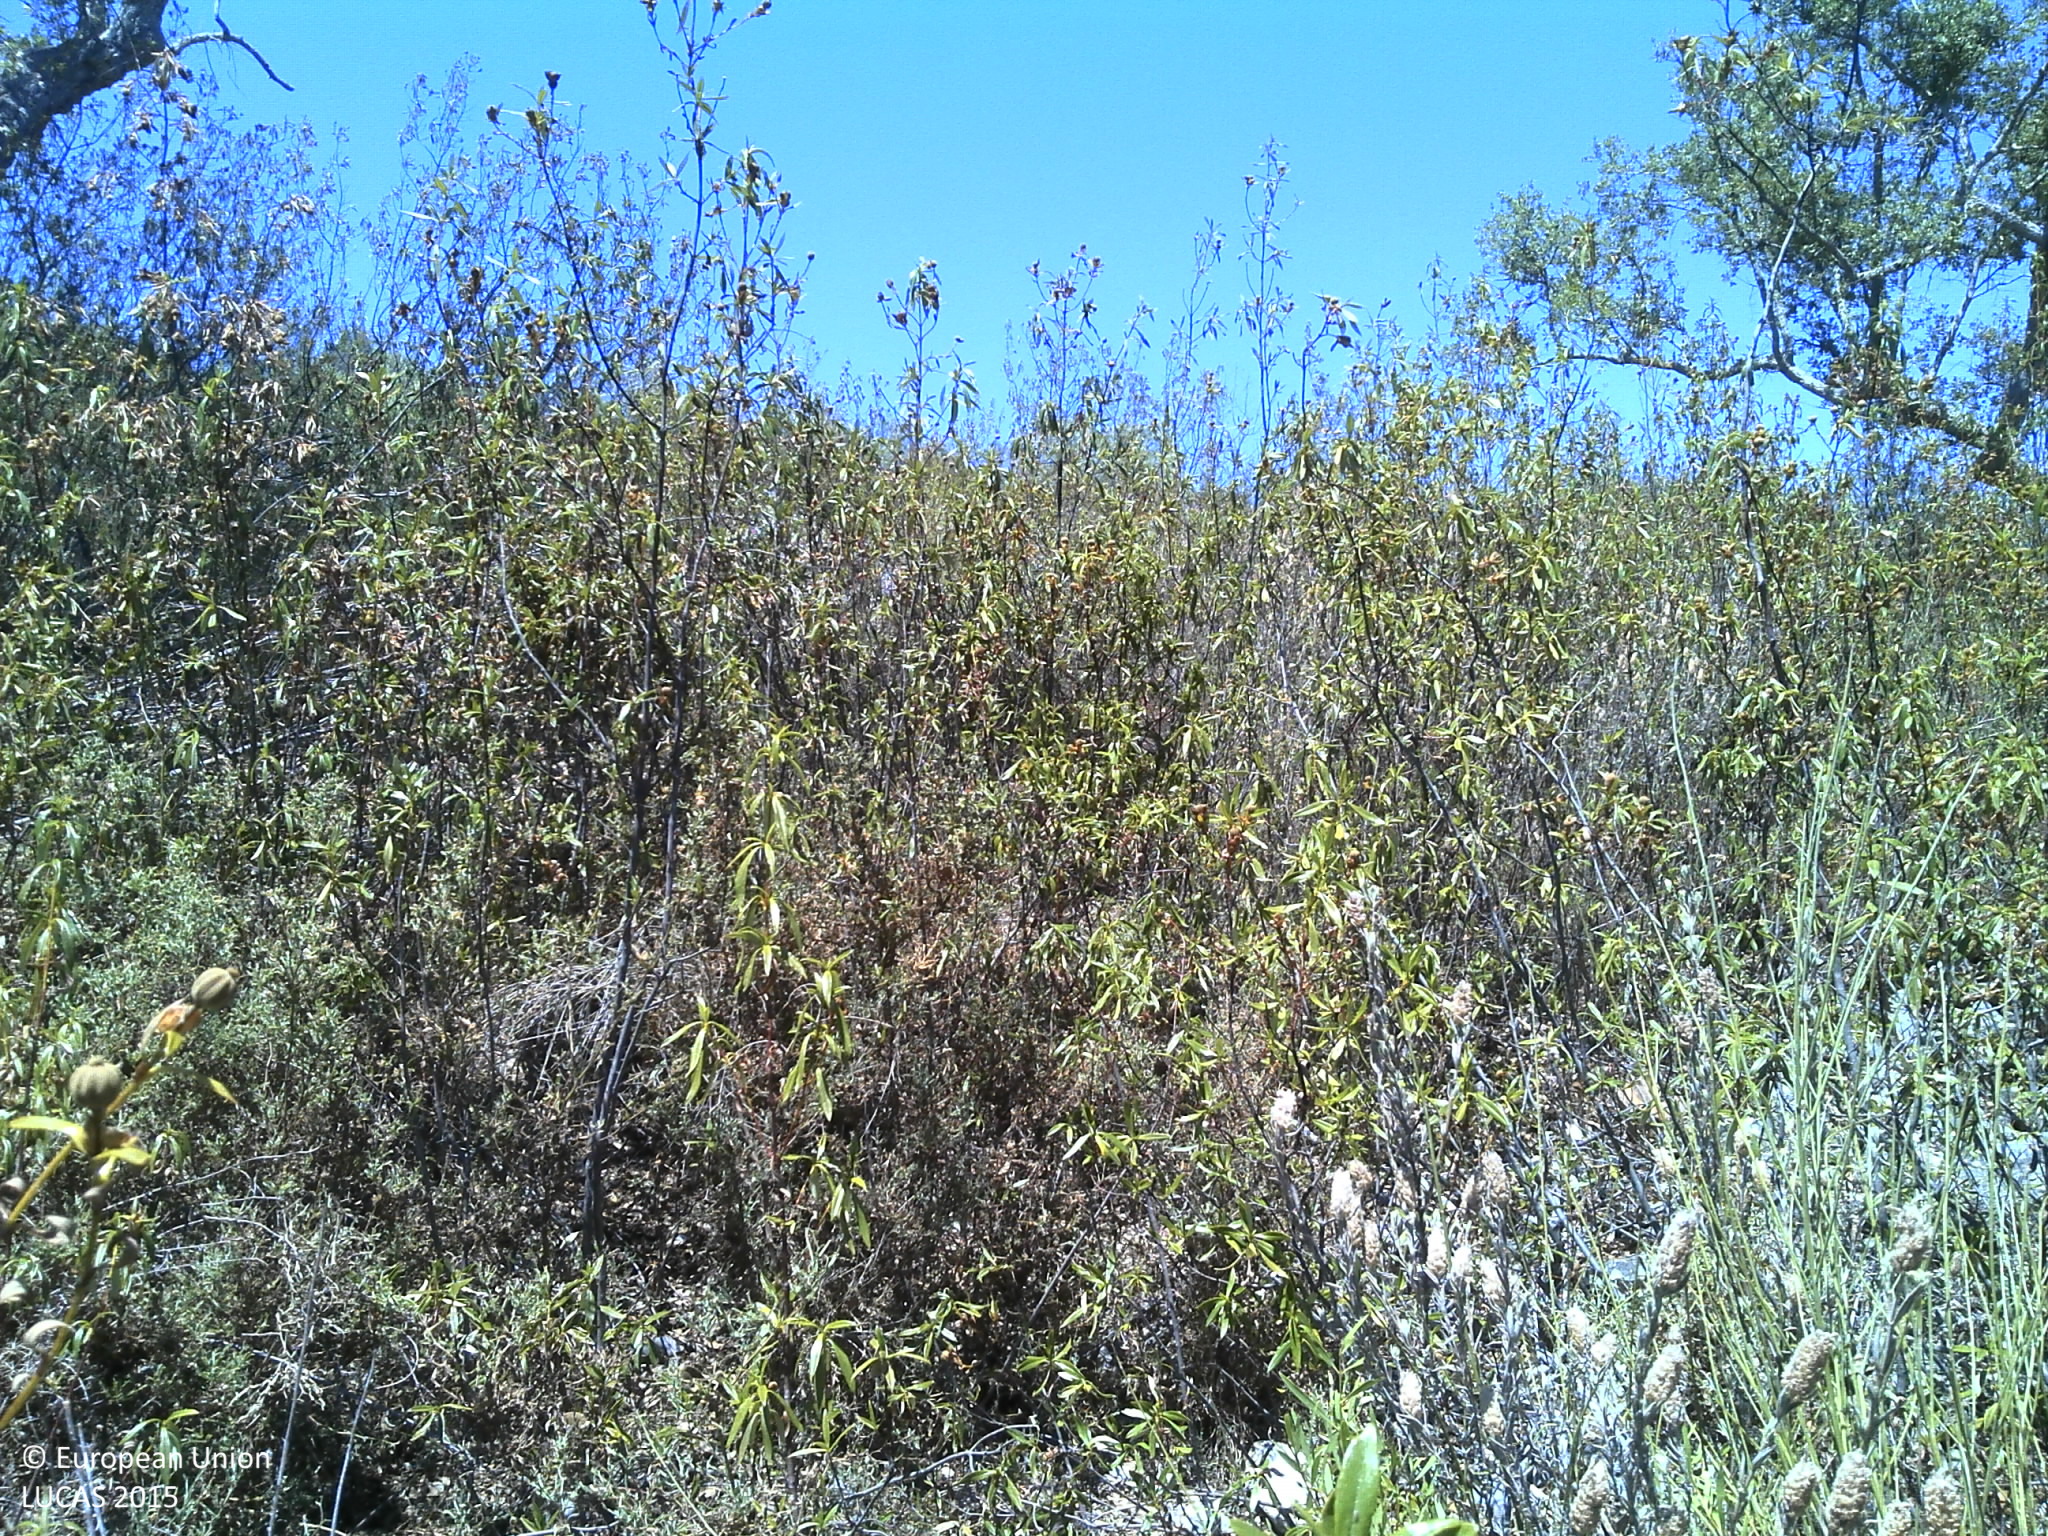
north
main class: Woodland
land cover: Broadleaved woodland
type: broadleaved evergreen forest
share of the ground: 25 - 50 %
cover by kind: shrubs 75 %, broadleaved forest trees 25 %
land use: Forestry
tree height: > 5 m
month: July
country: PT
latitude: 39.1469
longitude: -7.1690
